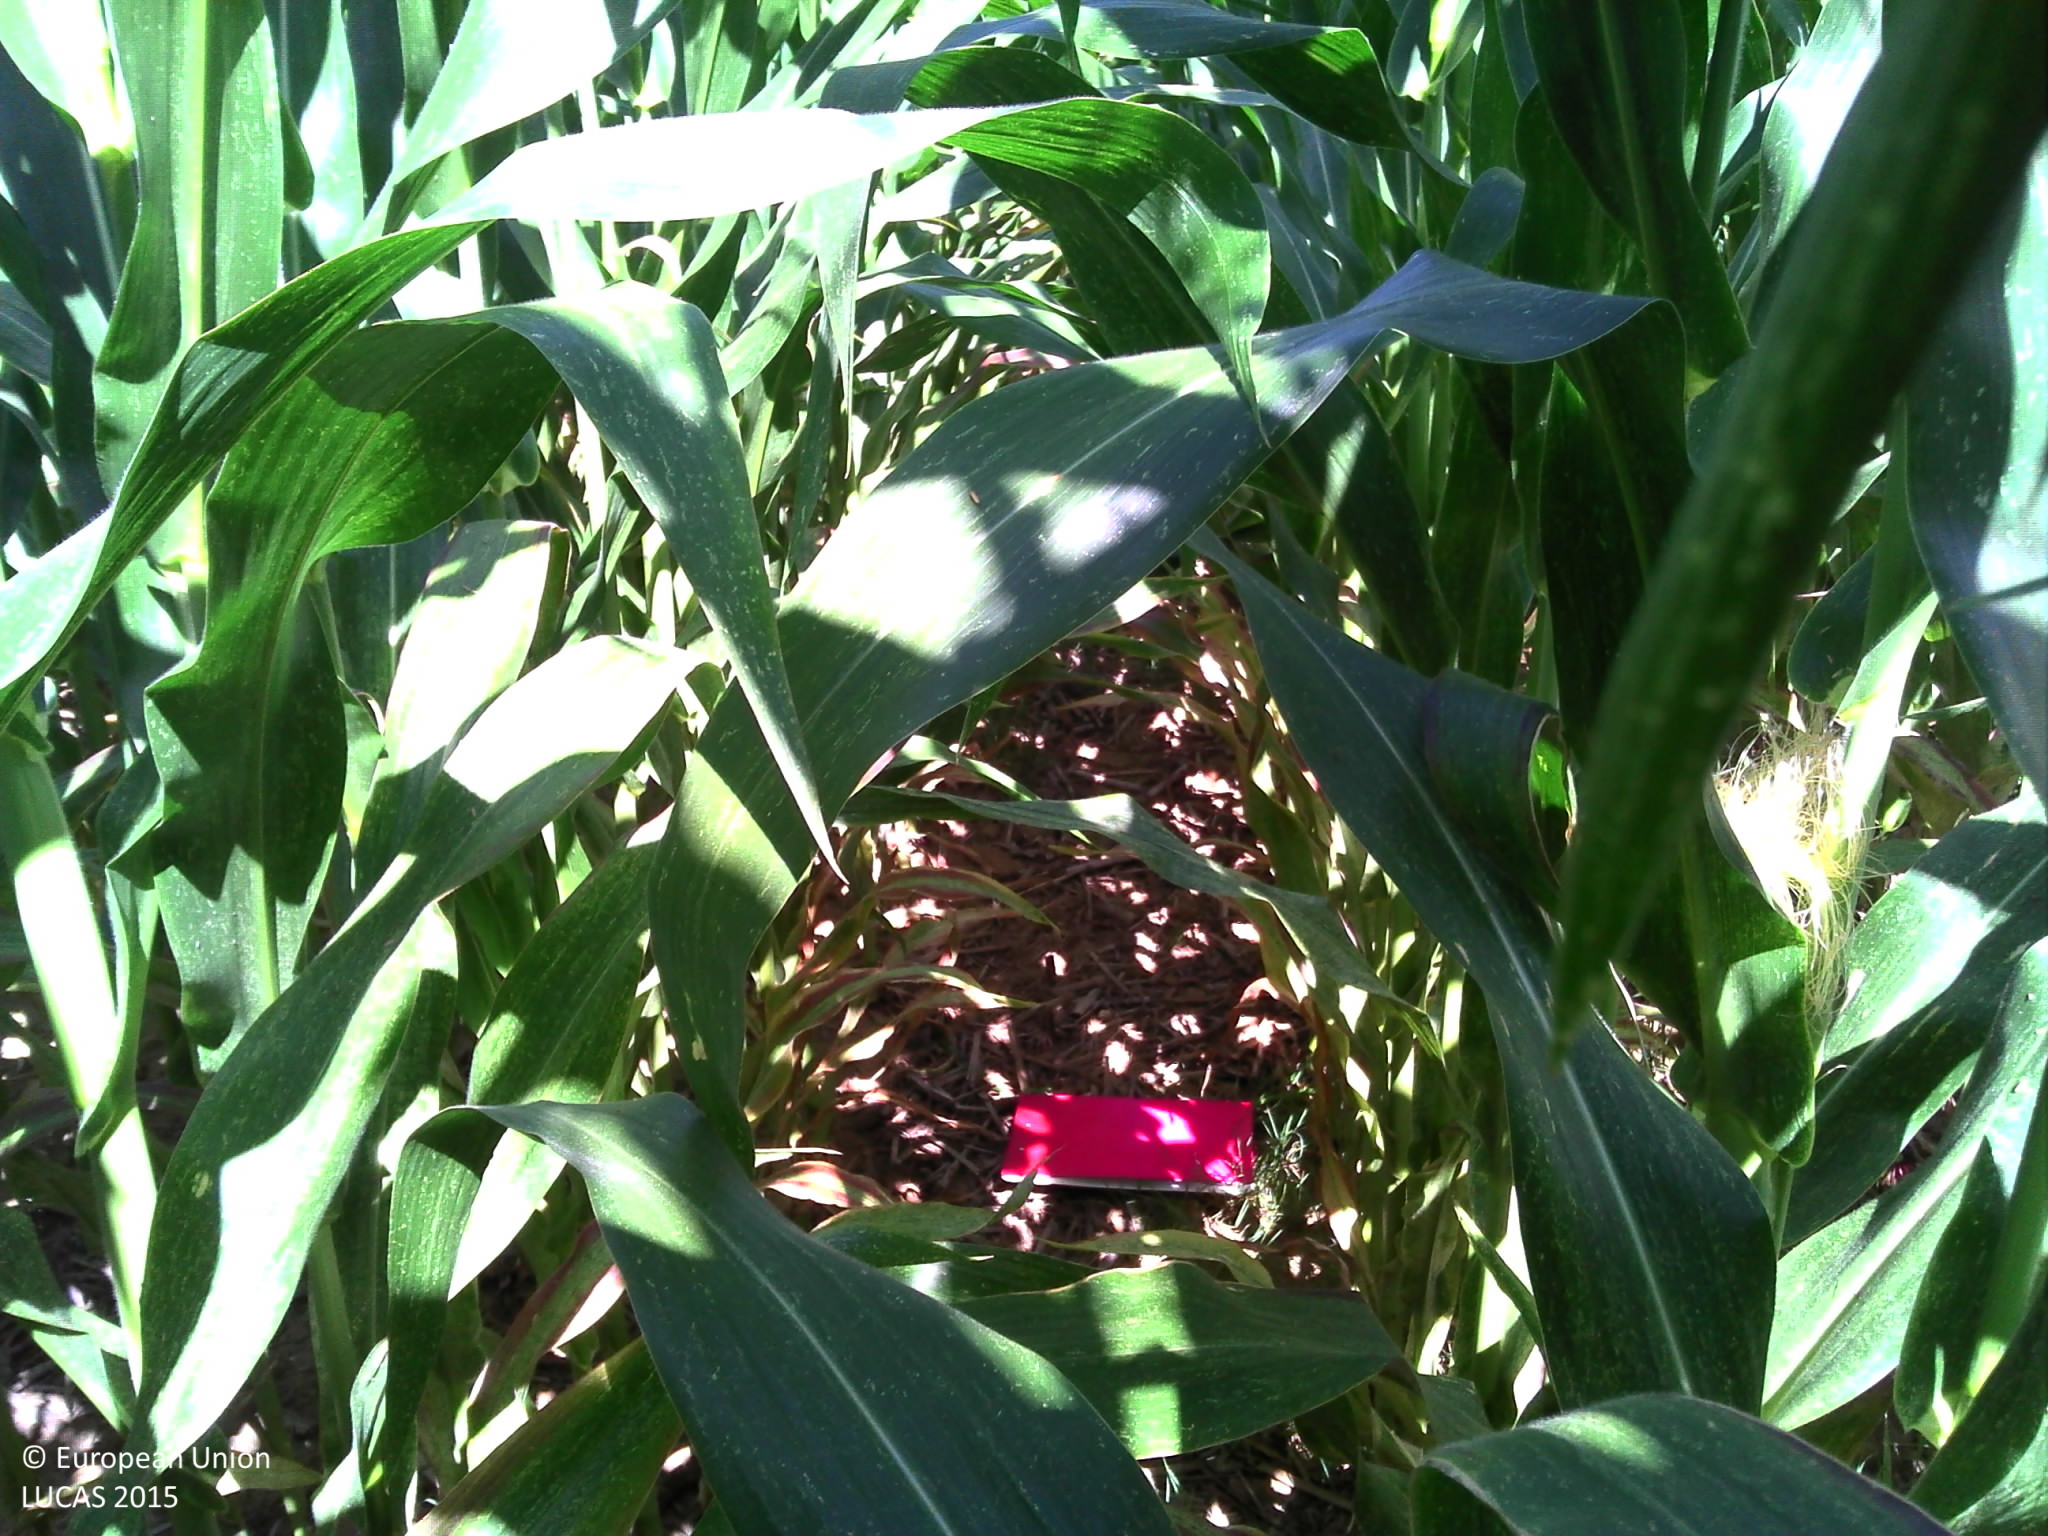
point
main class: Cropland
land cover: Maize
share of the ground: > 75 %
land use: Agriculture (excluding fallow land and kitchen gardens)
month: July
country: FR
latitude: 43.9515
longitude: 0.7134
